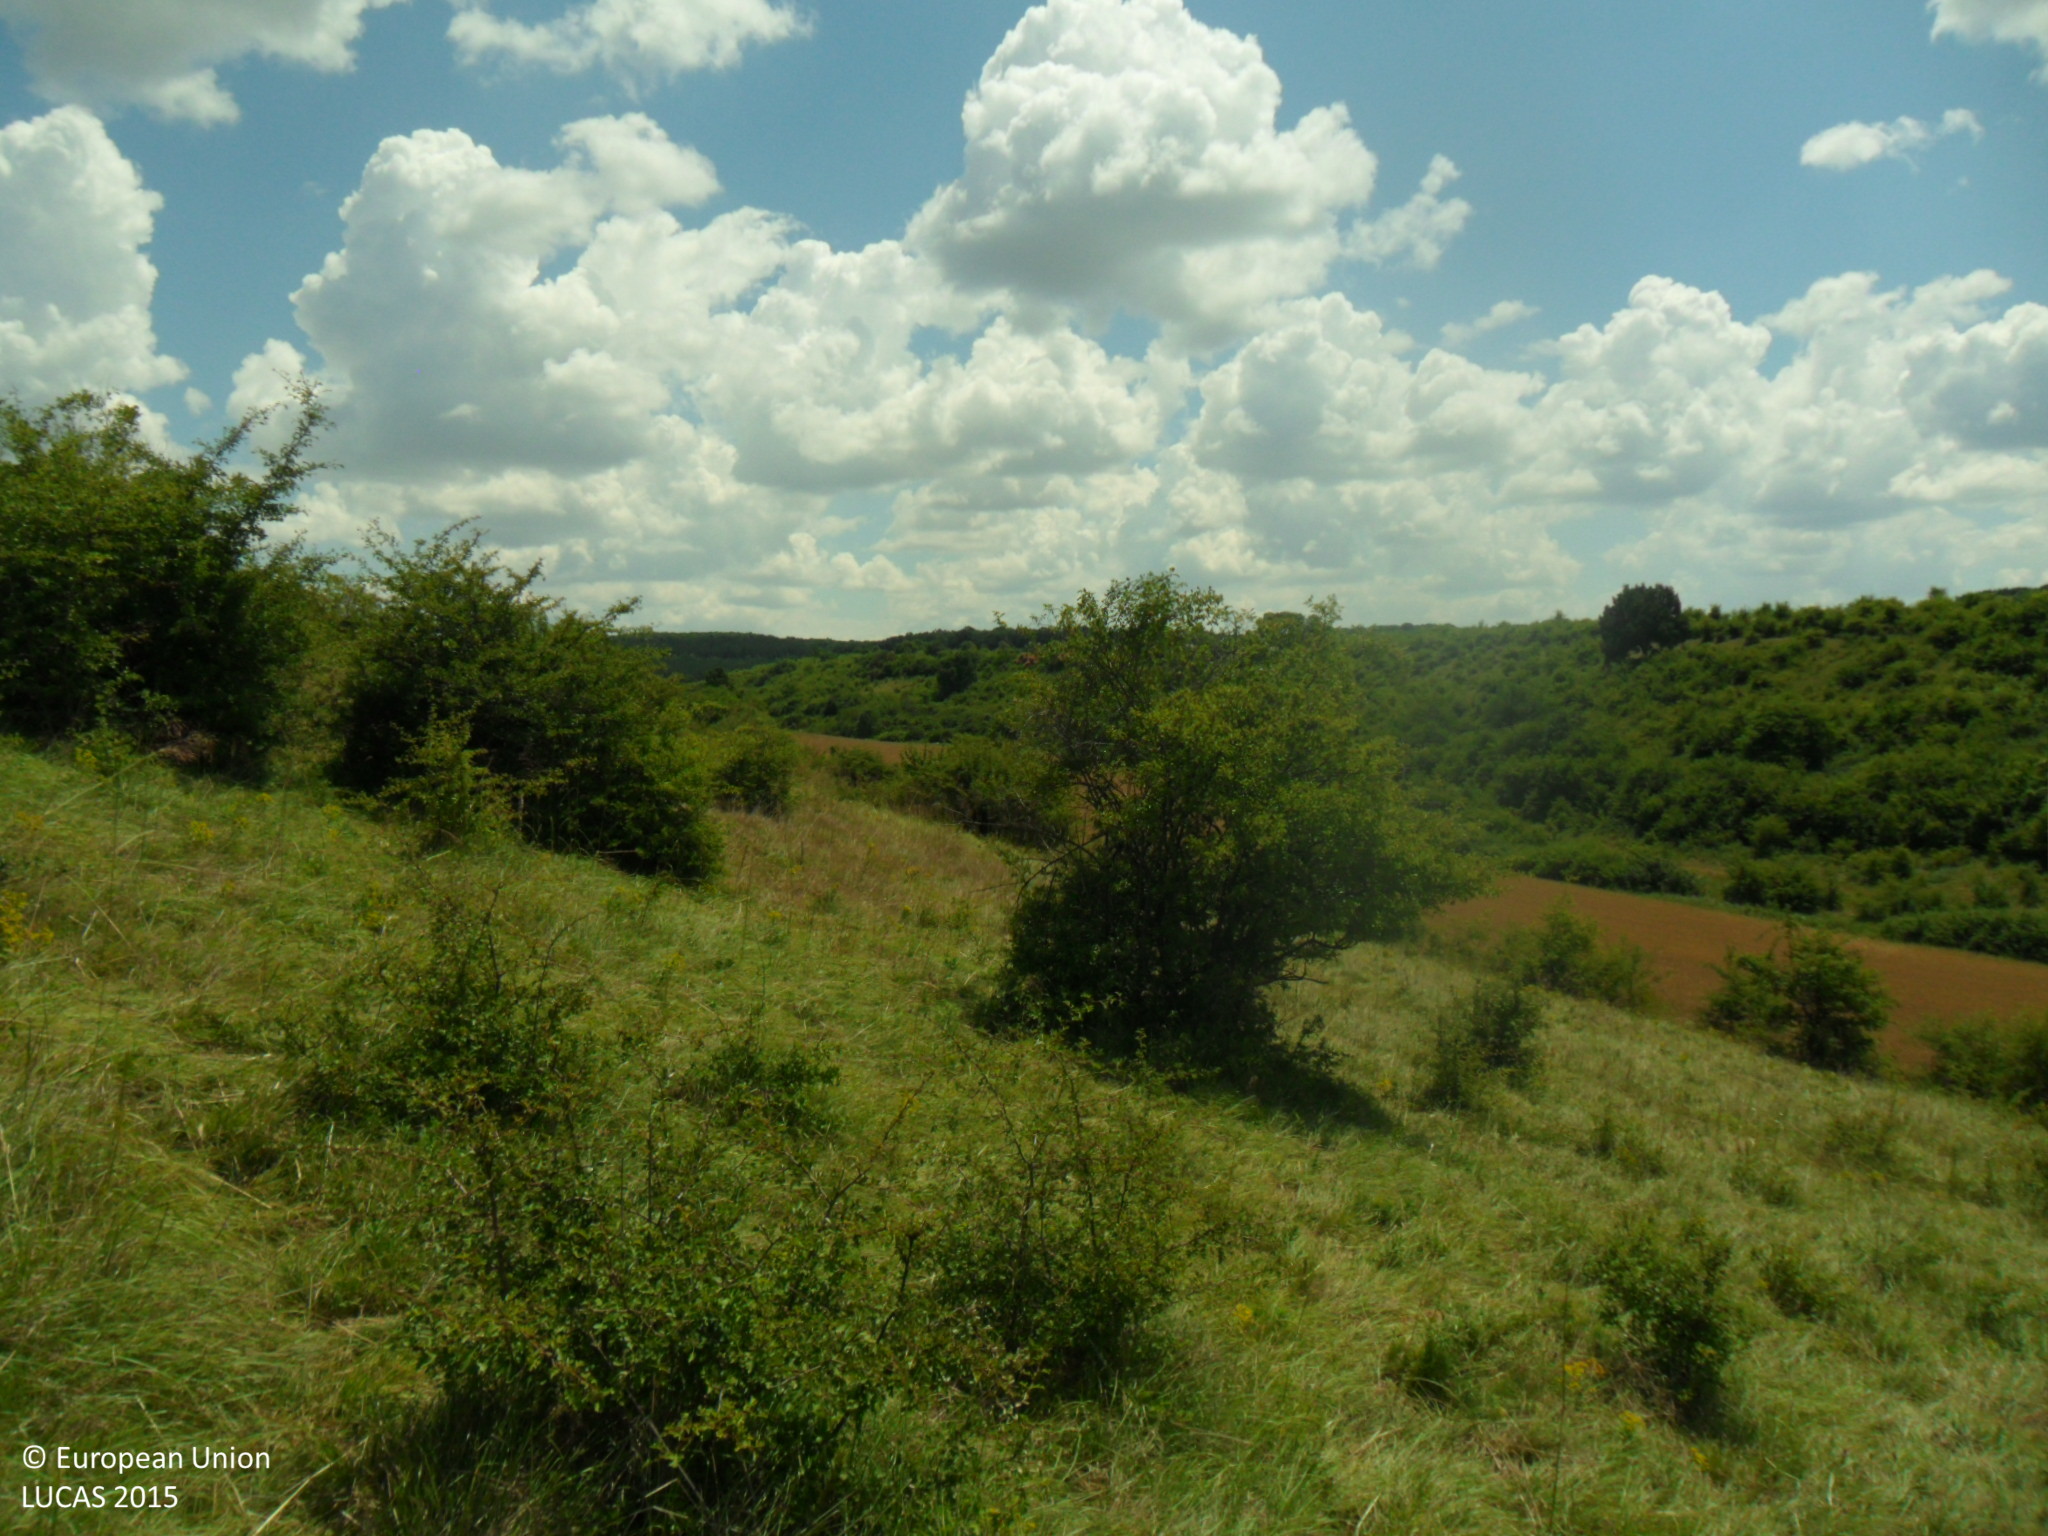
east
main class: Grassland
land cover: Grassland with sparse tree/shrub cover
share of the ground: > 75 %
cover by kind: herbaceous plants 85 %, shrubs 10 %, broadleaved forest trees 5 %
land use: Agriculture (excluding fallow land and kitchen gardens)
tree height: < 5 m
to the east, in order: Grassland with sparse tree/shrub cover; Other bare soil; Grassland with sparse tree/shrub cover; Other bare soil; Grassland with sparse tree/shrub cover
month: June
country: BG
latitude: 43.4152
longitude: 26.7709
